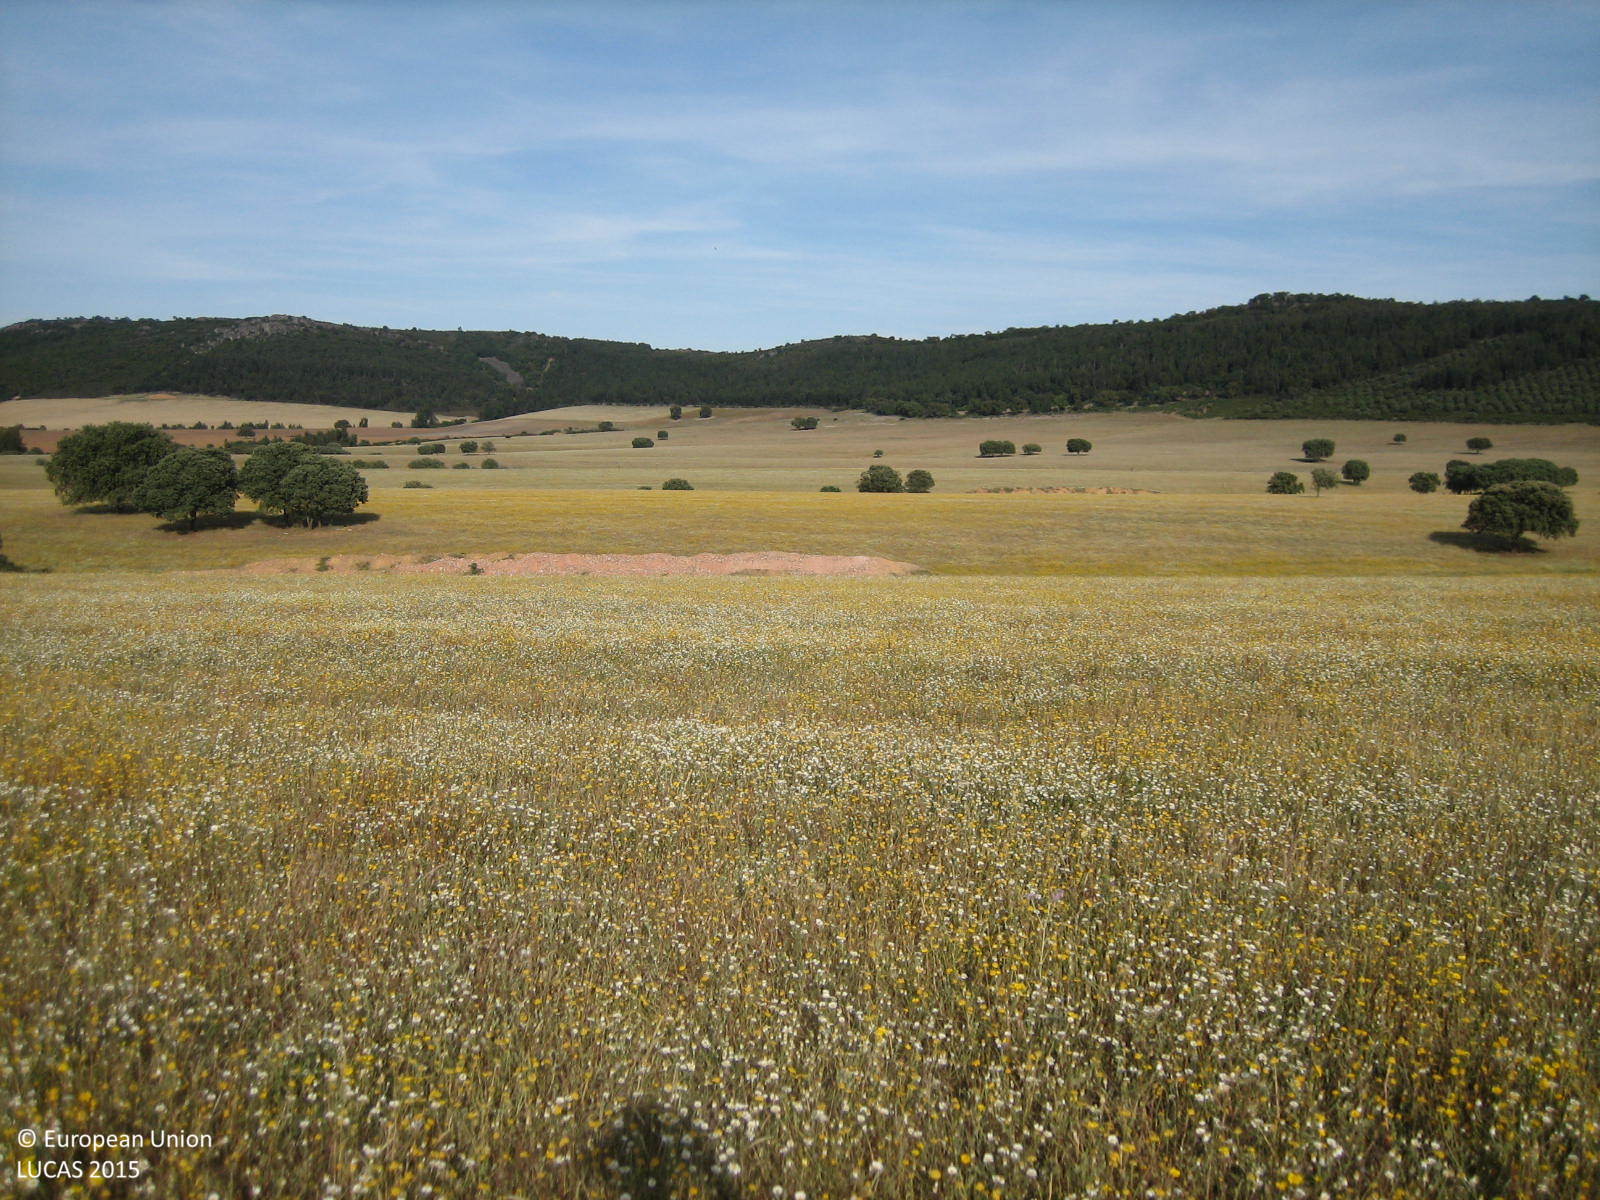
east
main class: Grassland
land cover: Spontaneously vegetated surfaces
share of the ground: > 75 %
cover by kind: herbaceous plants 100 %
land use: Agriculture (excluding fallow land and kitchen gardens)
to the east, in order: Spontaneously vegetated surfaces; Inland fresh water bodies; Spontaneously vegetated surfaces
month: May
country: ES
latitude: 39.0656
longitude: -4.7923
